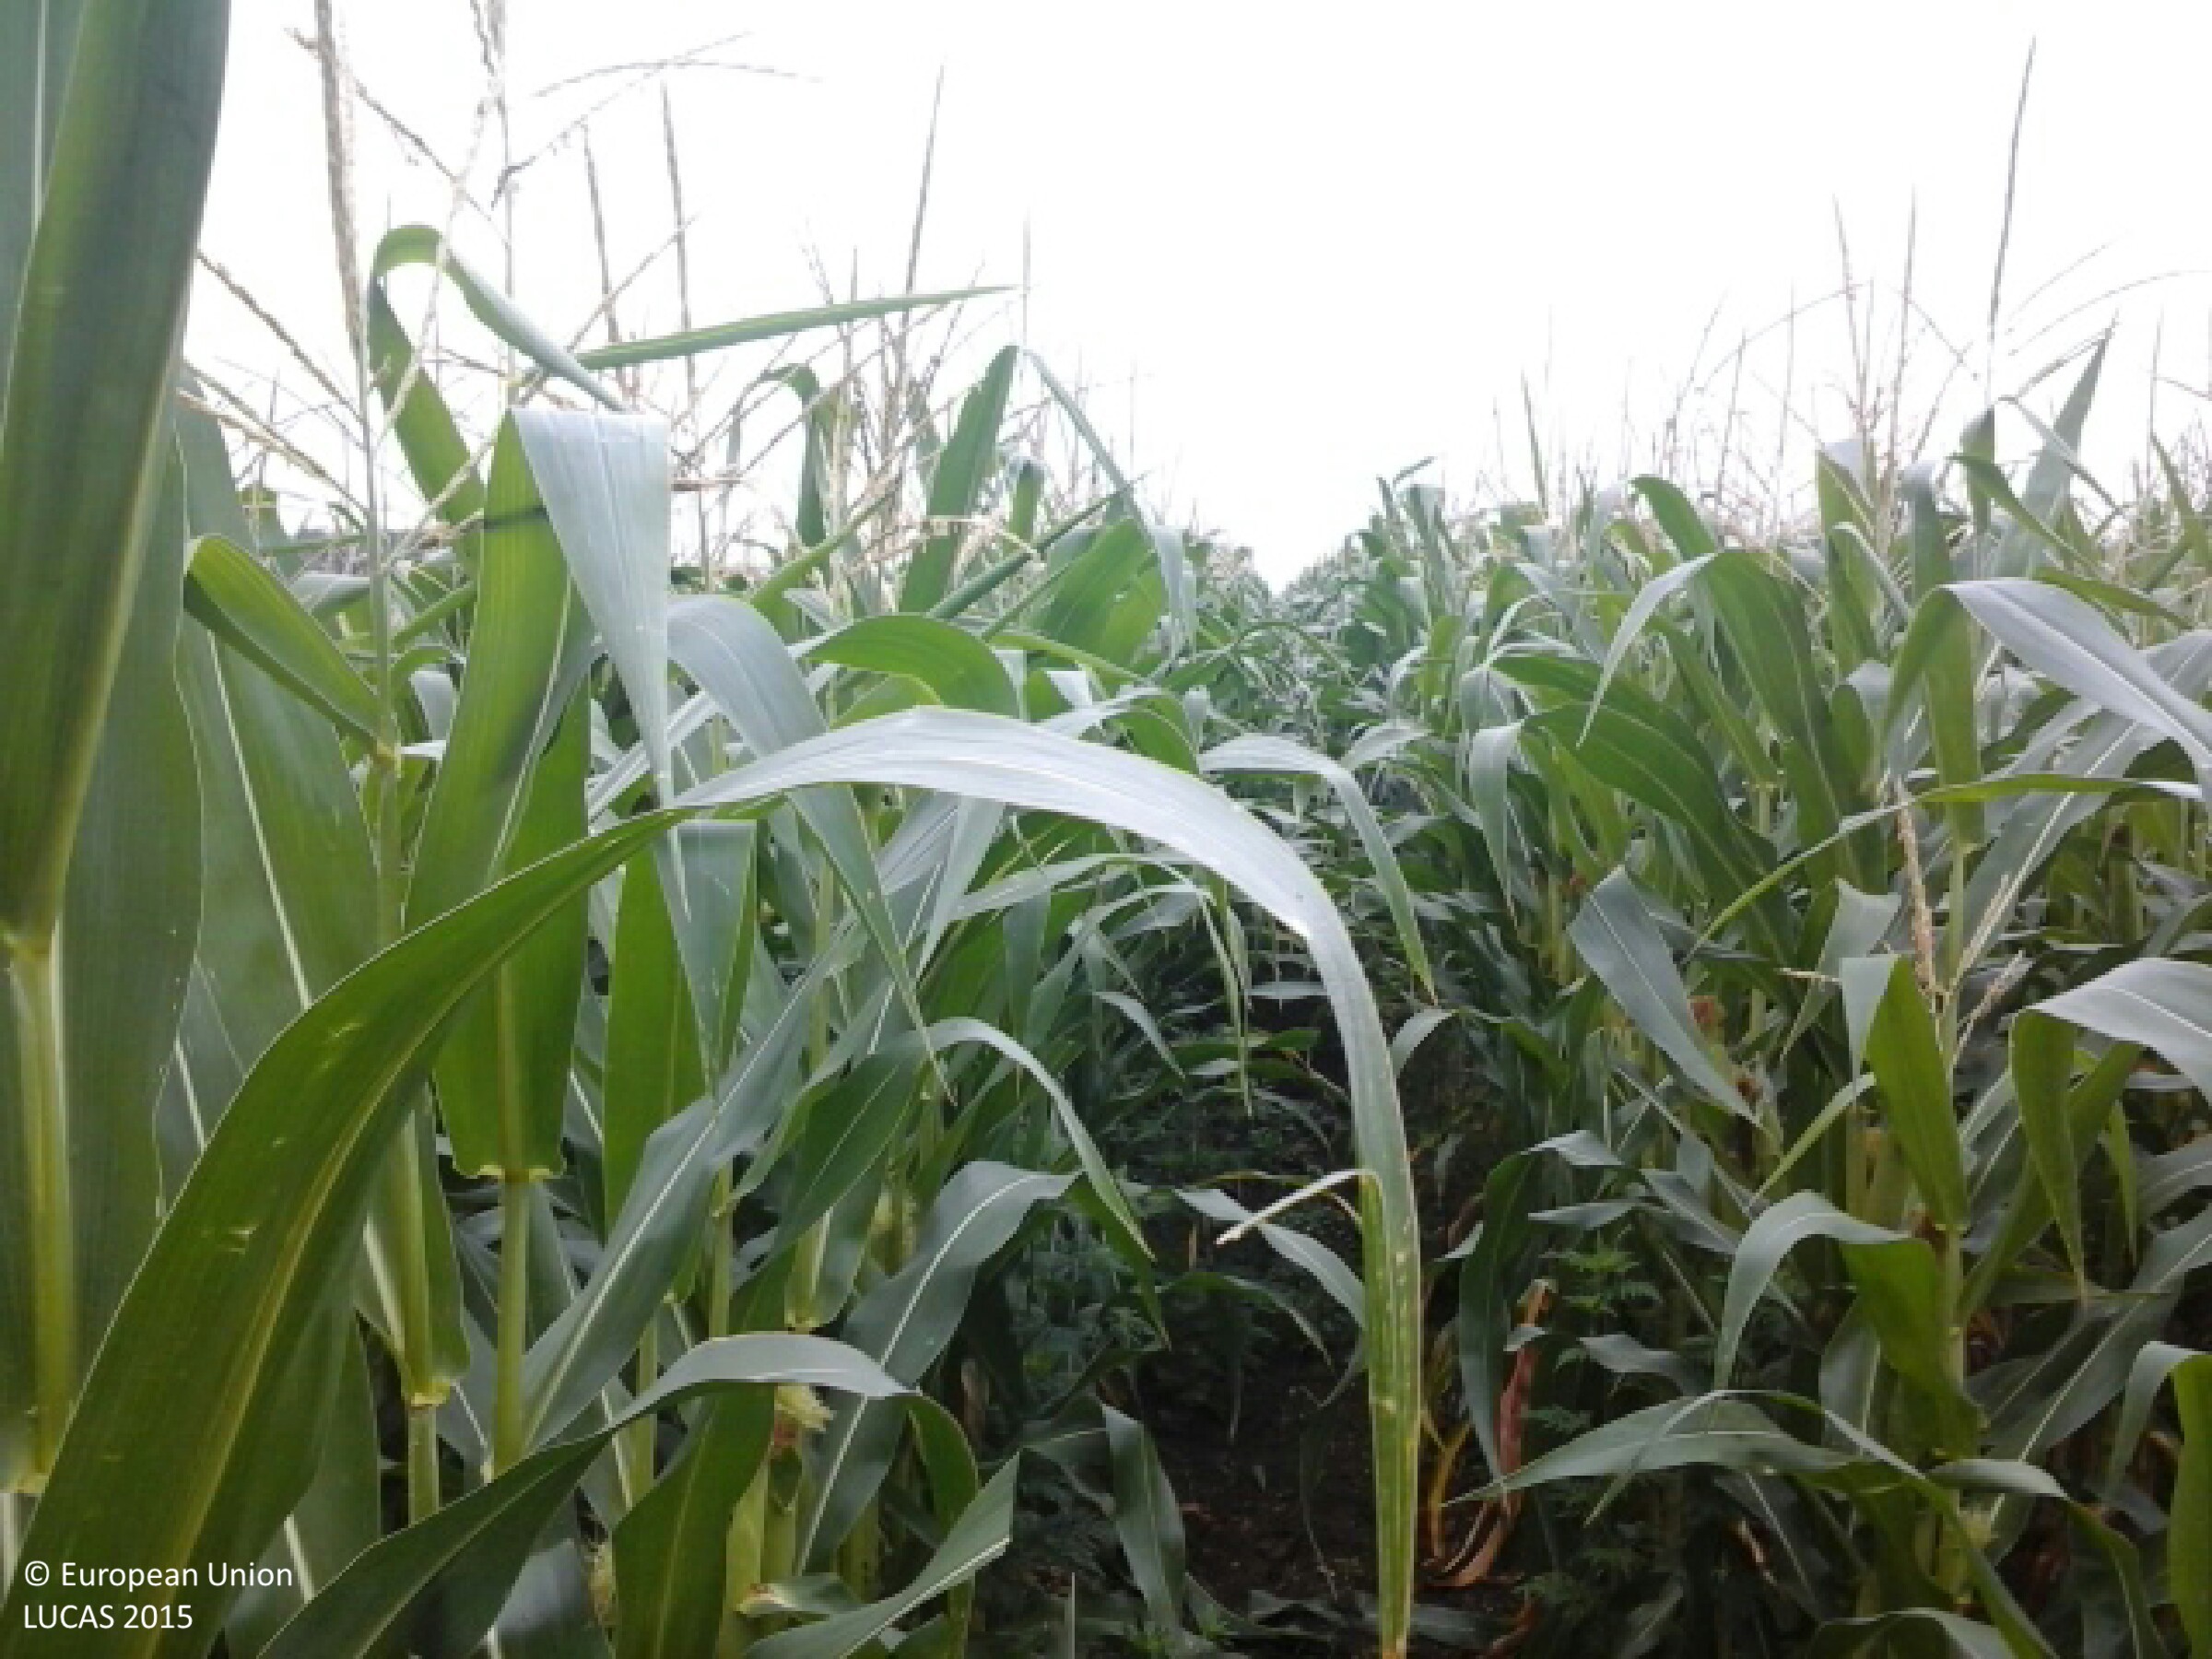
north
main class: Cropland
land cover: Maize
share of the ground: > 75 %
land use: Agriculture (excluding fallow land and kitchen gardens)
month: July
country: HU
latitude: 48.3600
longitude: 21.0131
